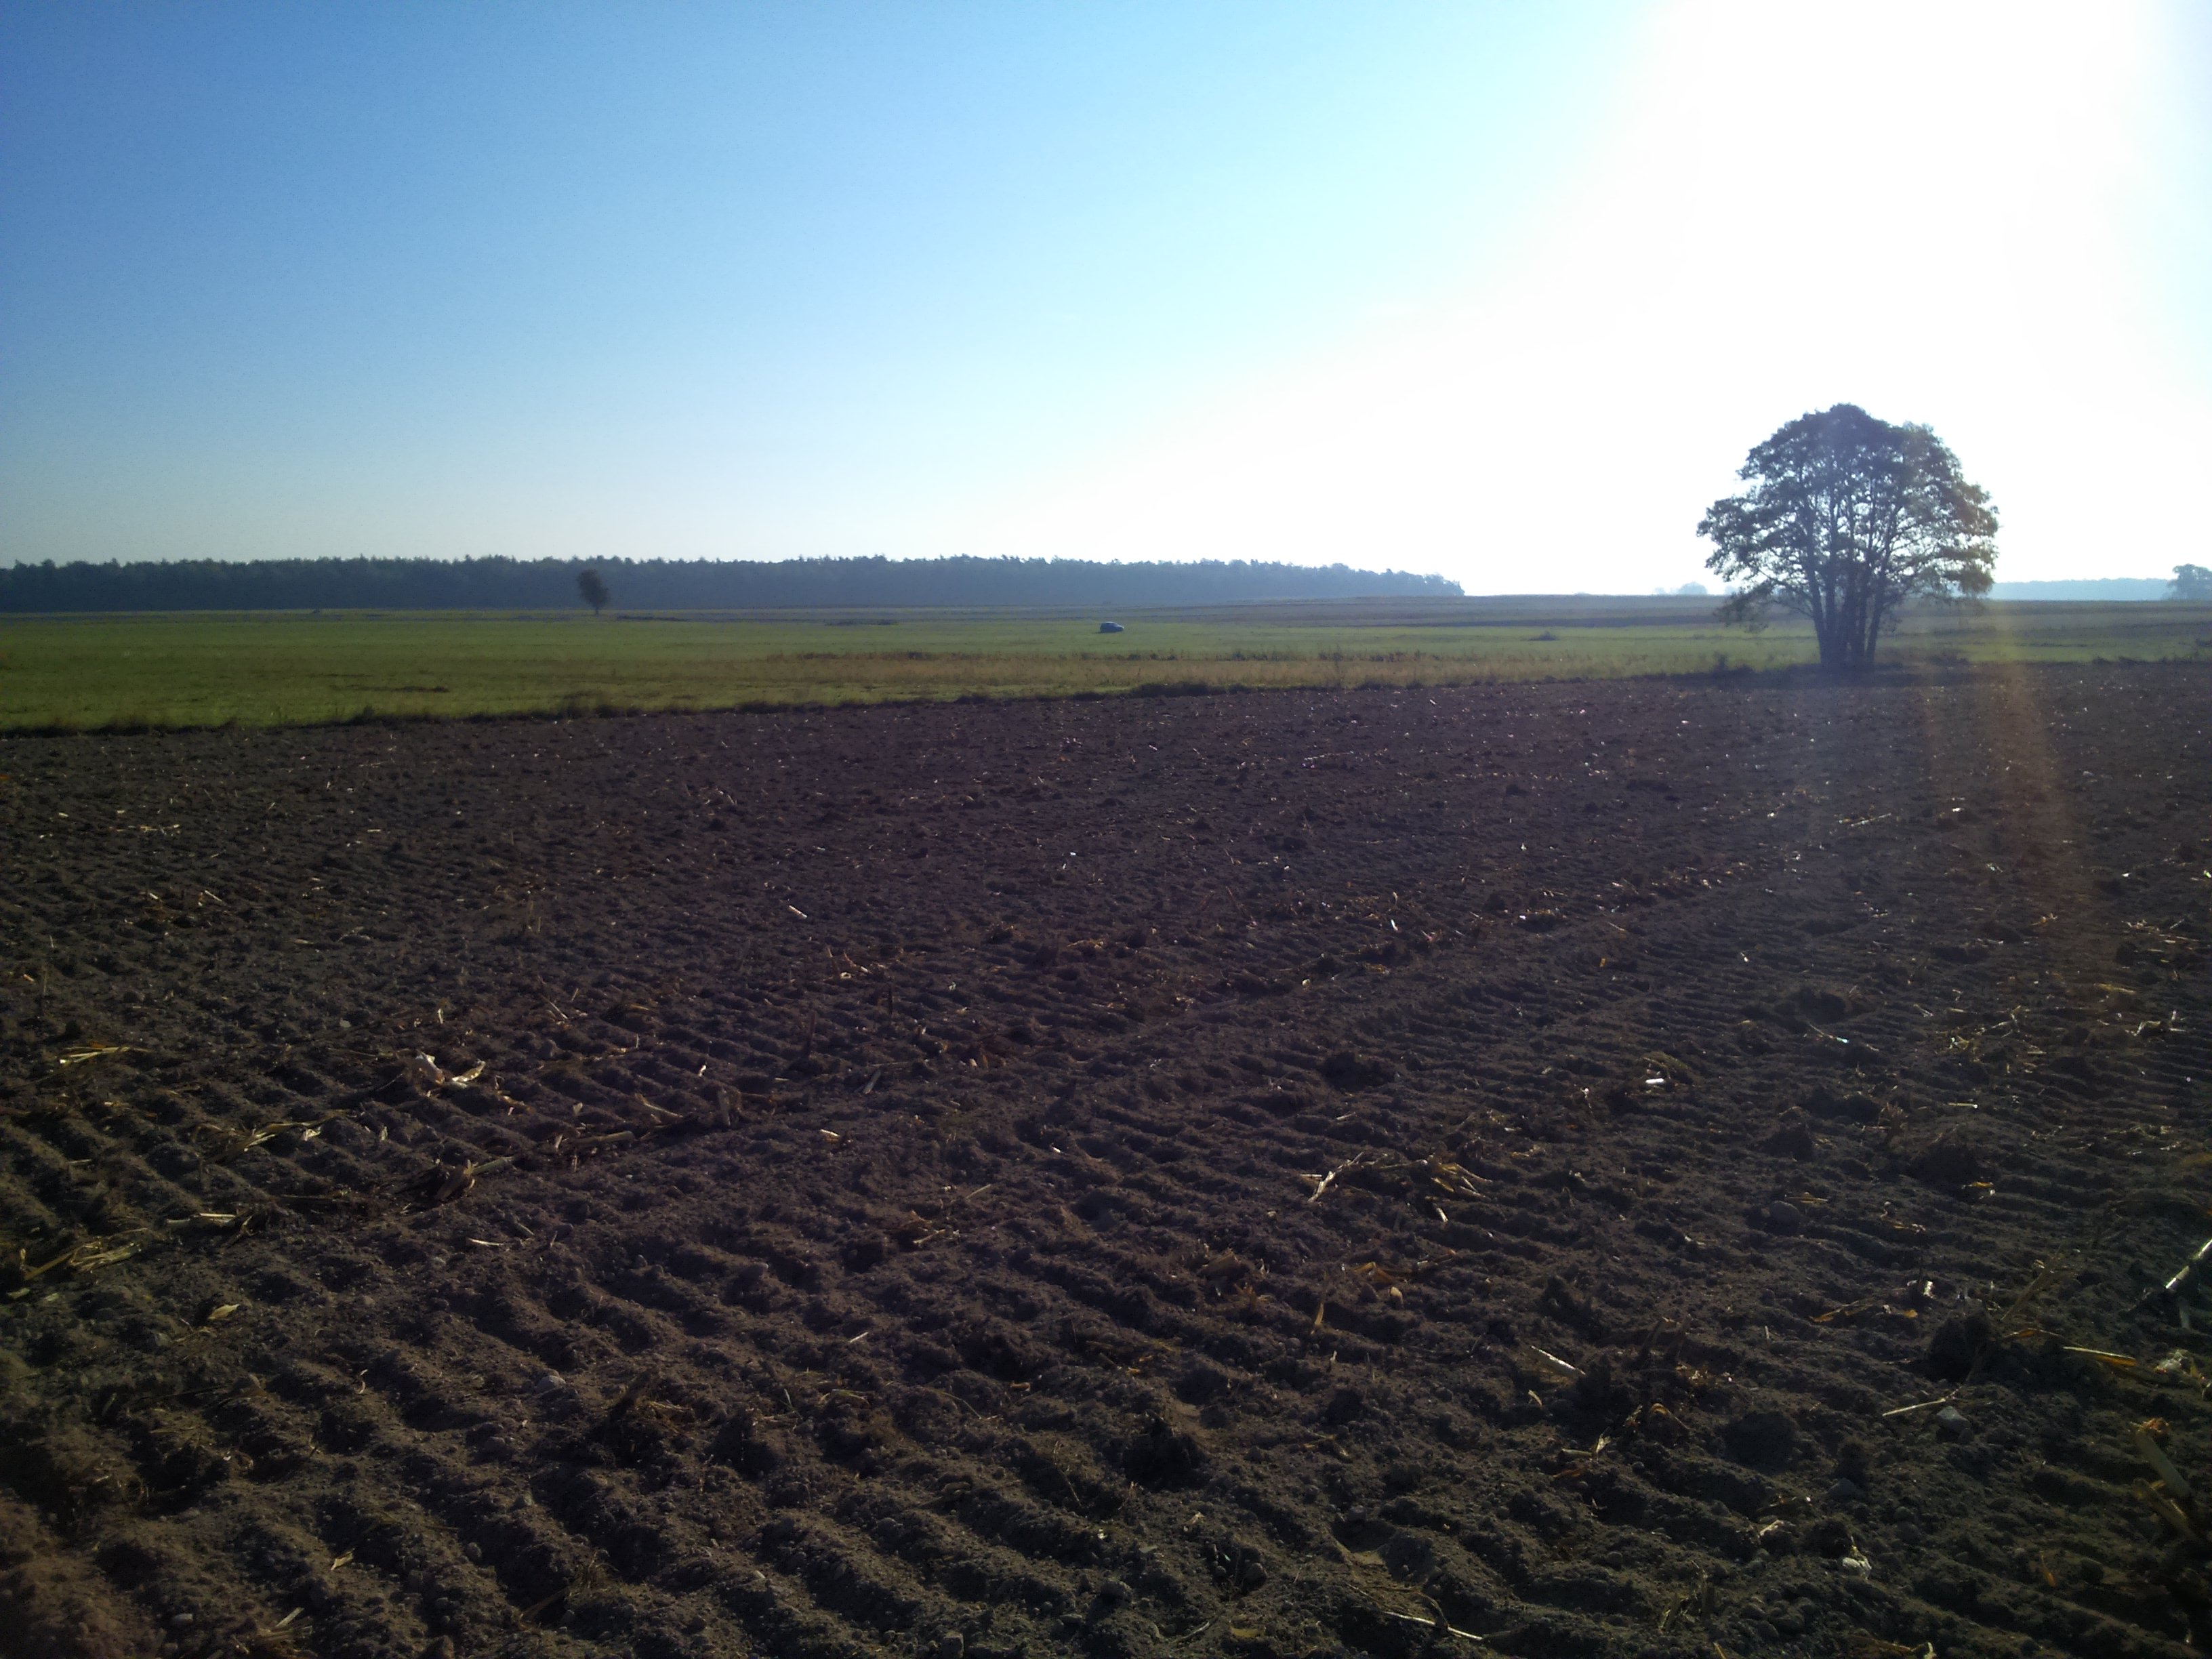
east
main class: Cropland
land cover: Maize
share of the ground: < 10 %
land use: Agriculture (excluding fallow land and kitchen gardens)
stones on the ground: < 10 %
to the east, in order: Maize; Triticale; Grassland without tree/shrub cover; Ditches and canals; Grassland without tree/shrub cover
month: September
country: PL
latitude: 52.4813
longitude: 22.1195
